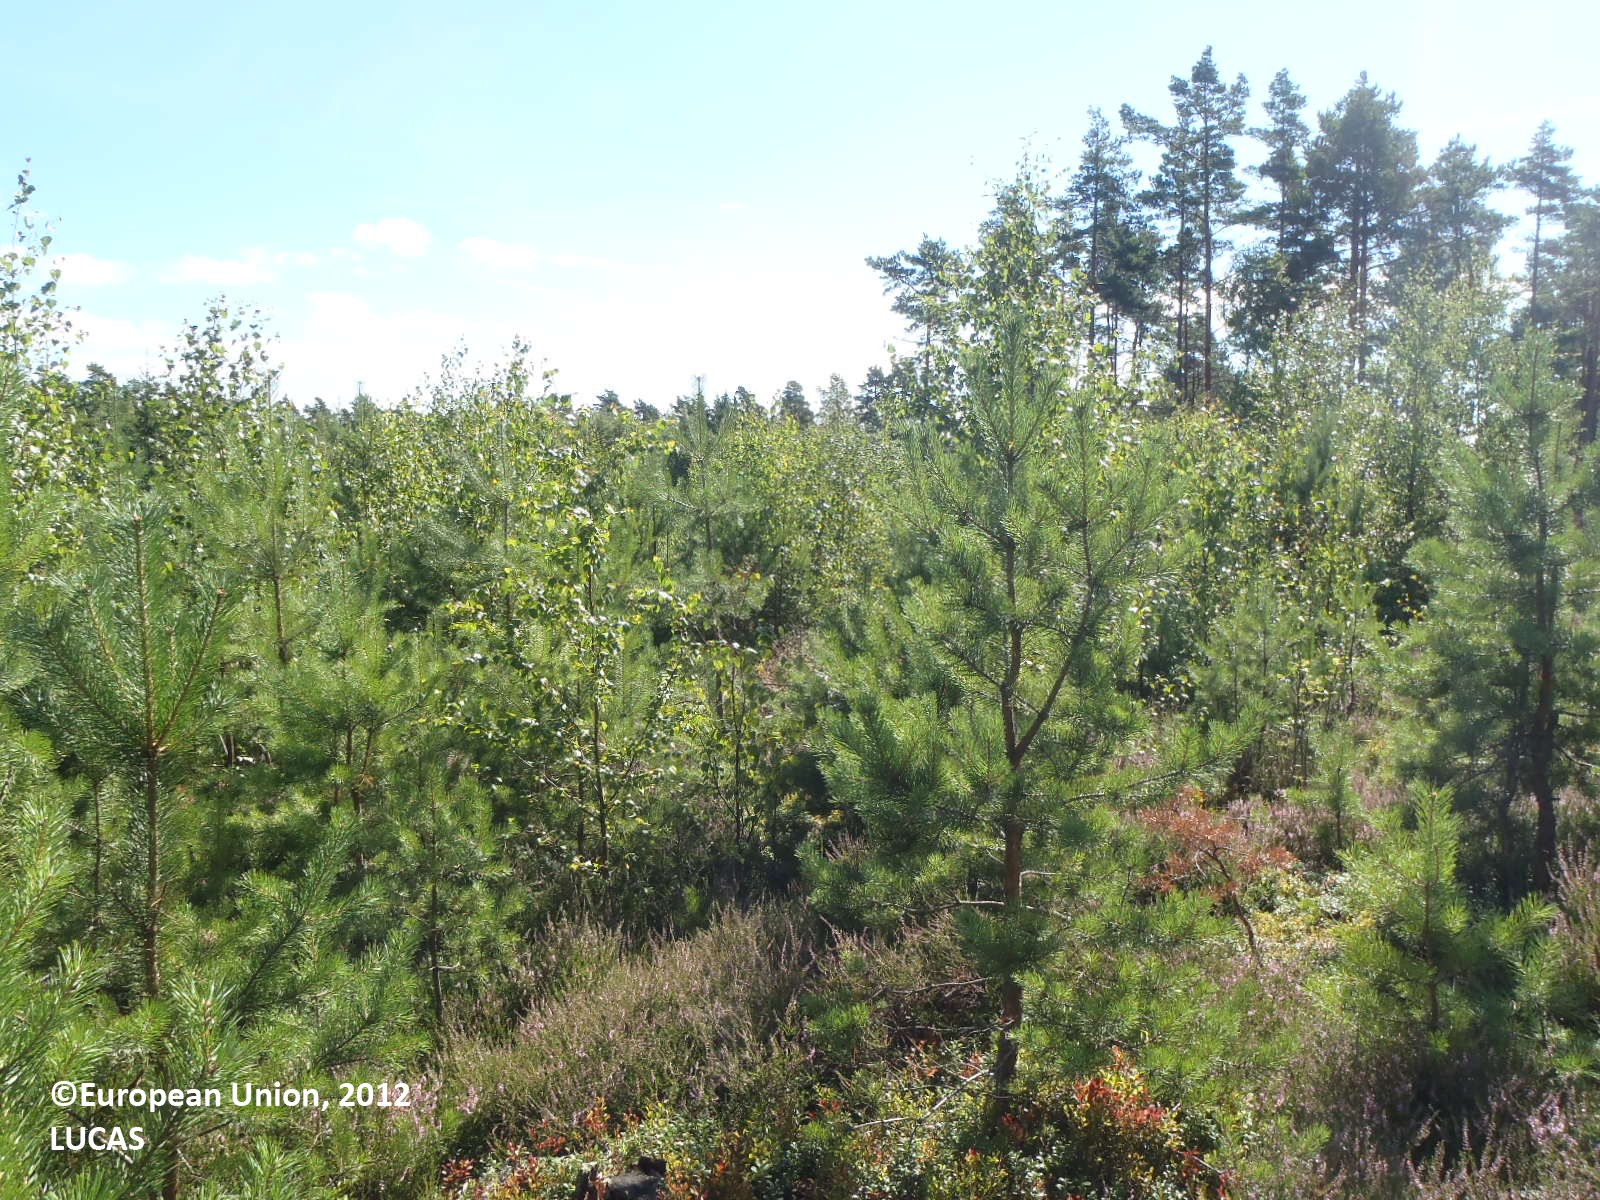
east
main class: Woodland
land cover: Pine dominated mixed woodland
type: boreal forest
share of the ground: 50 - 75 %
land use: Forestry
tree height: < 5 m
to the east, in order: Pine dominated mixed woodland; Ditches and canals; Broadleaved woodland; Ditches and canals; Grass margins; Other mixed woodland; Pine dominated coniferous woodland
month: August
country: FI
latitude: 60.1932
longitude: 22.0228
